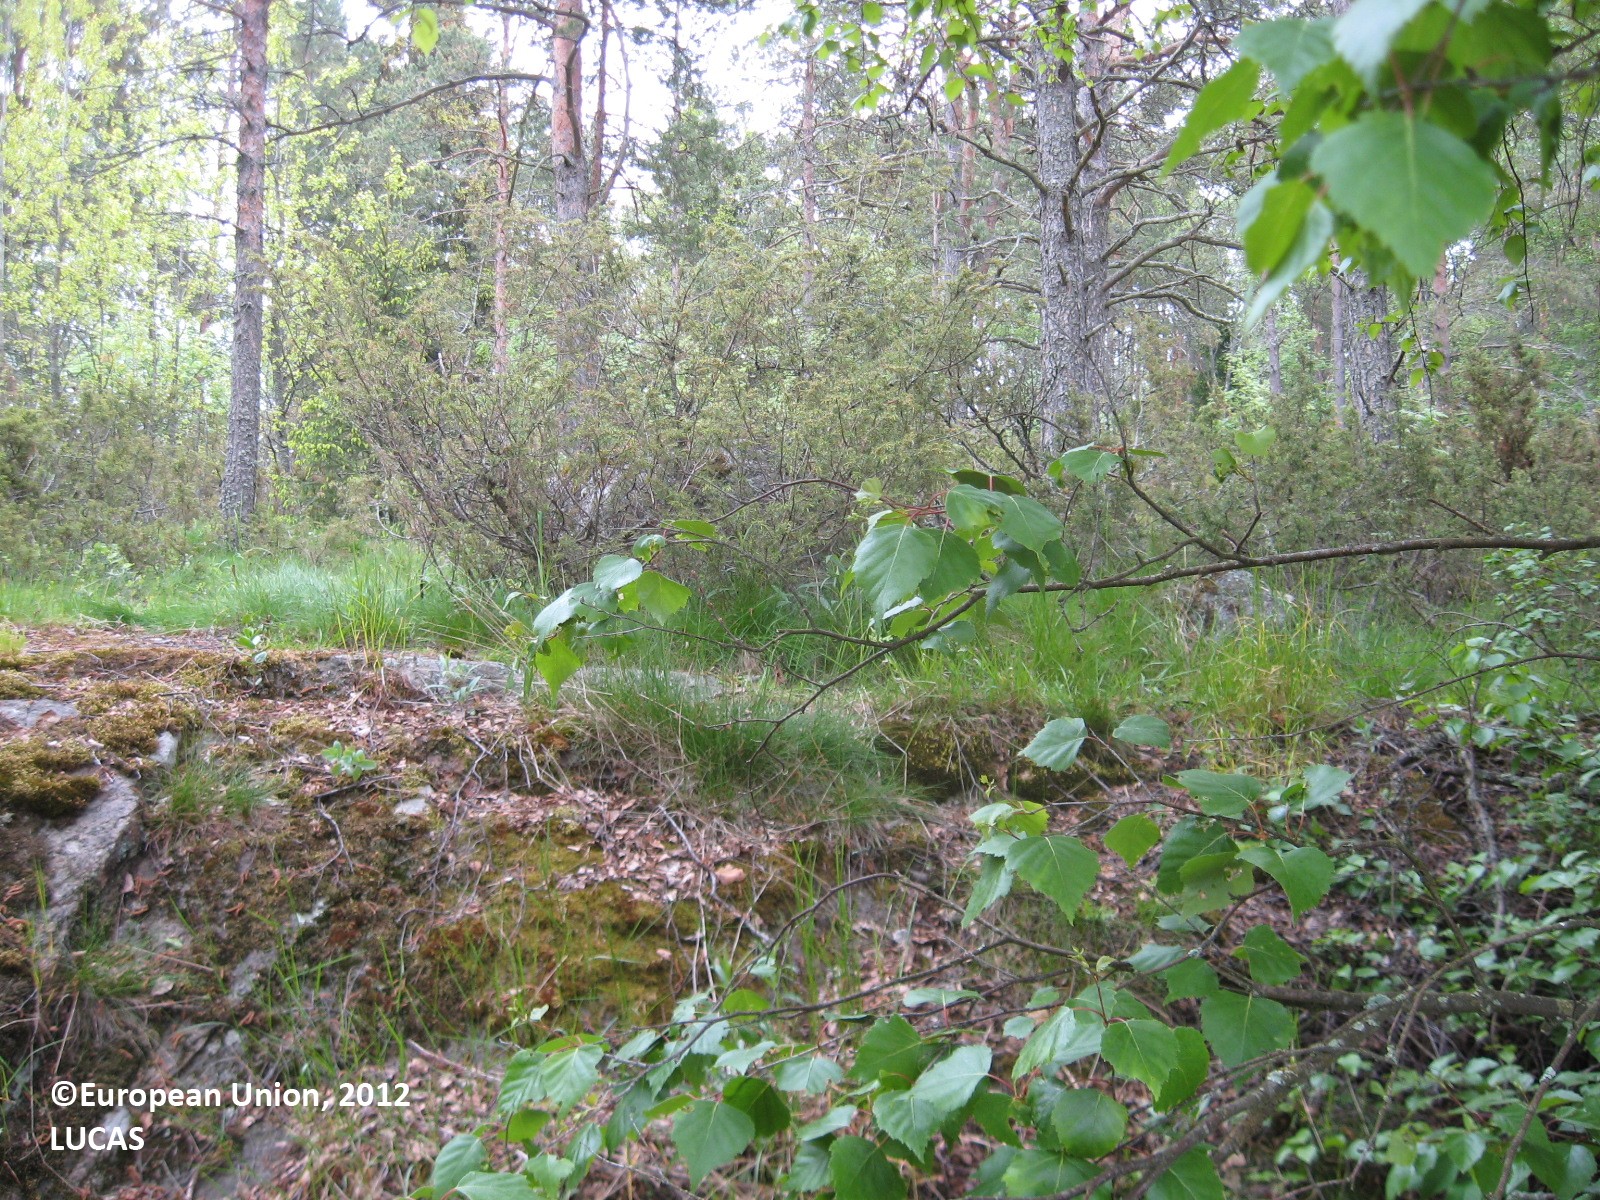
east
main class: Woodland
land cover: Broadleaved woodland
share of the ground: > 75 %
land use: Forestry
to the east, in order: Broadleaved woodland; Pine dominated mixed woodland; Broadleaved woodland; Oats; Lines of trees; Ditches and canals; Lines of trees; Barley
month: June
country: FI
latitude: 63.1037
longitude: 21.7114
